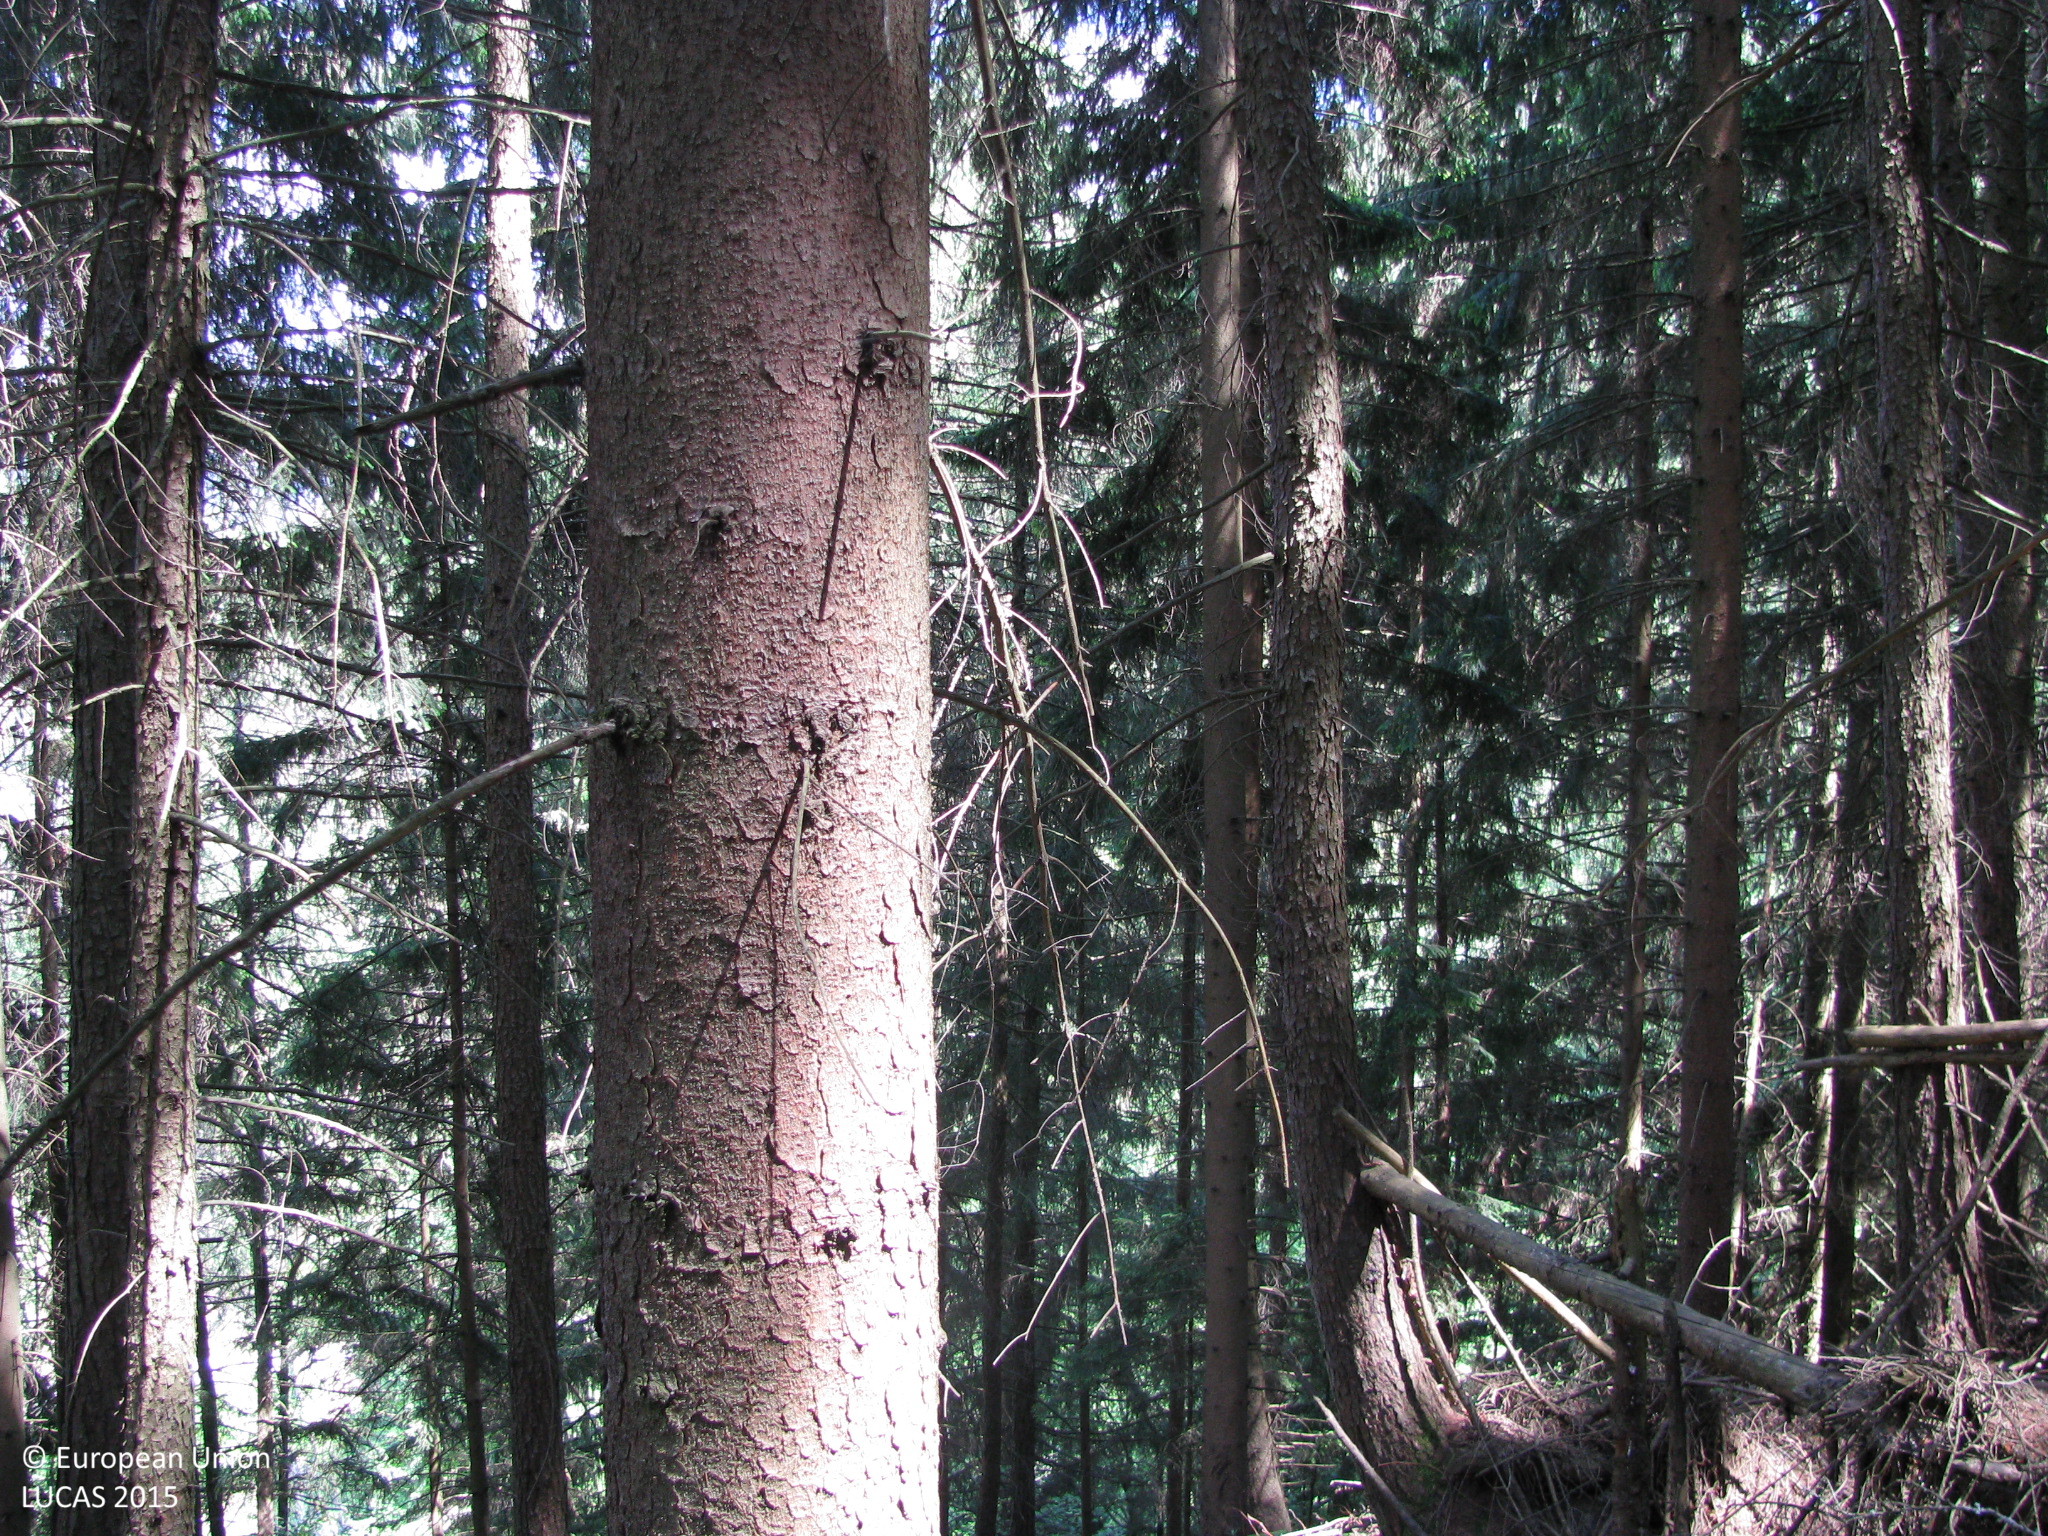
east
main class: Woodland
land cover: Spruce dominated coniferous woodland
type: alpine coniferous forest
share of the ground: > 75 %
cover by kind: coniferous forest trees 90 %, unconsolidated bare surface 10 %
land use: Forestry
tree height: > 5 m
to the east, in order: Spruce dominated coniferous woodland; Tracks; Fences; Grassland without tree/shrub cover; Broadleaved woodland; Grassland without tree/shrub cover; Fences; Abandoned hedges; Ditches and canals; Abandoned hedges; Tracks; Spruce dominated coniferous woodland
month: June
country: AT
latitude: 47.3724
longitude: 14.9658
